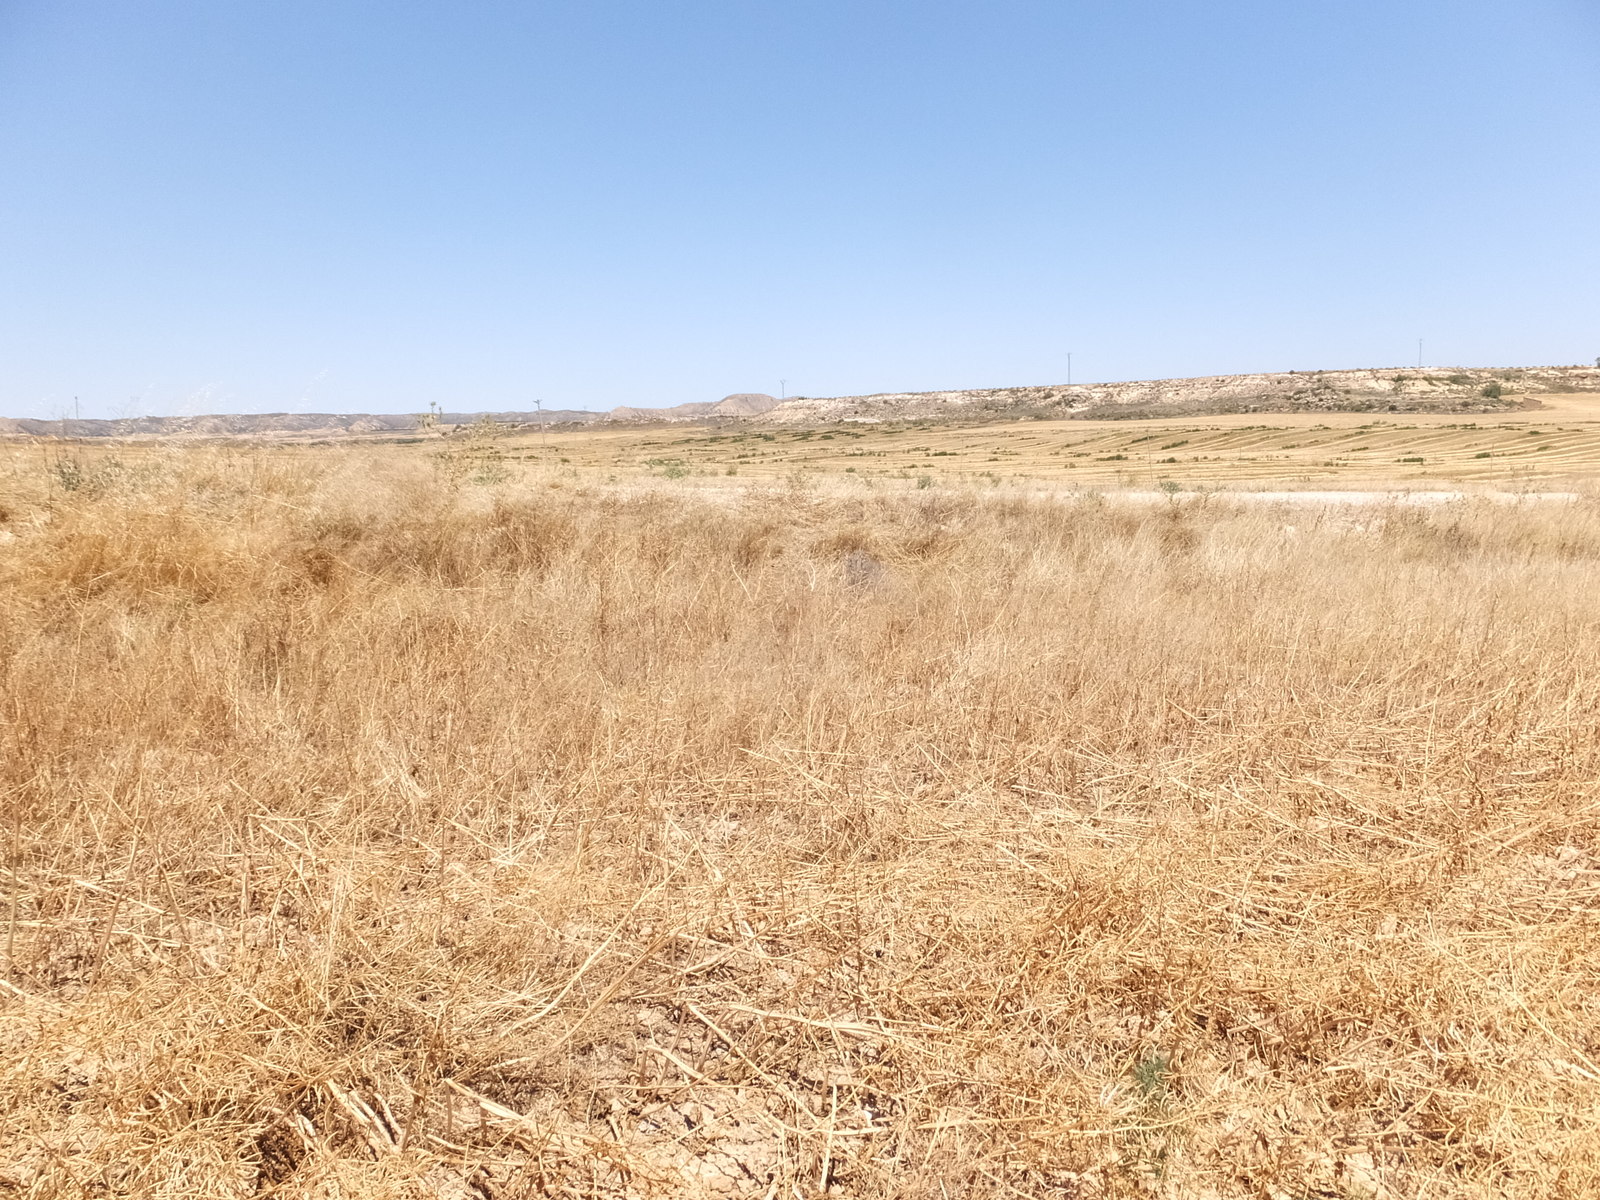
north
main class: Grassland
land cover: Spontaneously vegetated surfaces
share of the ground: > 75 %
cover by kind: herbaceous plants 90 %, unconsolidated bare surface 10 %
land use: Fallow land
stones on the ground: < 10 %
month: June
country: ES
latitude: 41.2948
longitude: -0.0802
